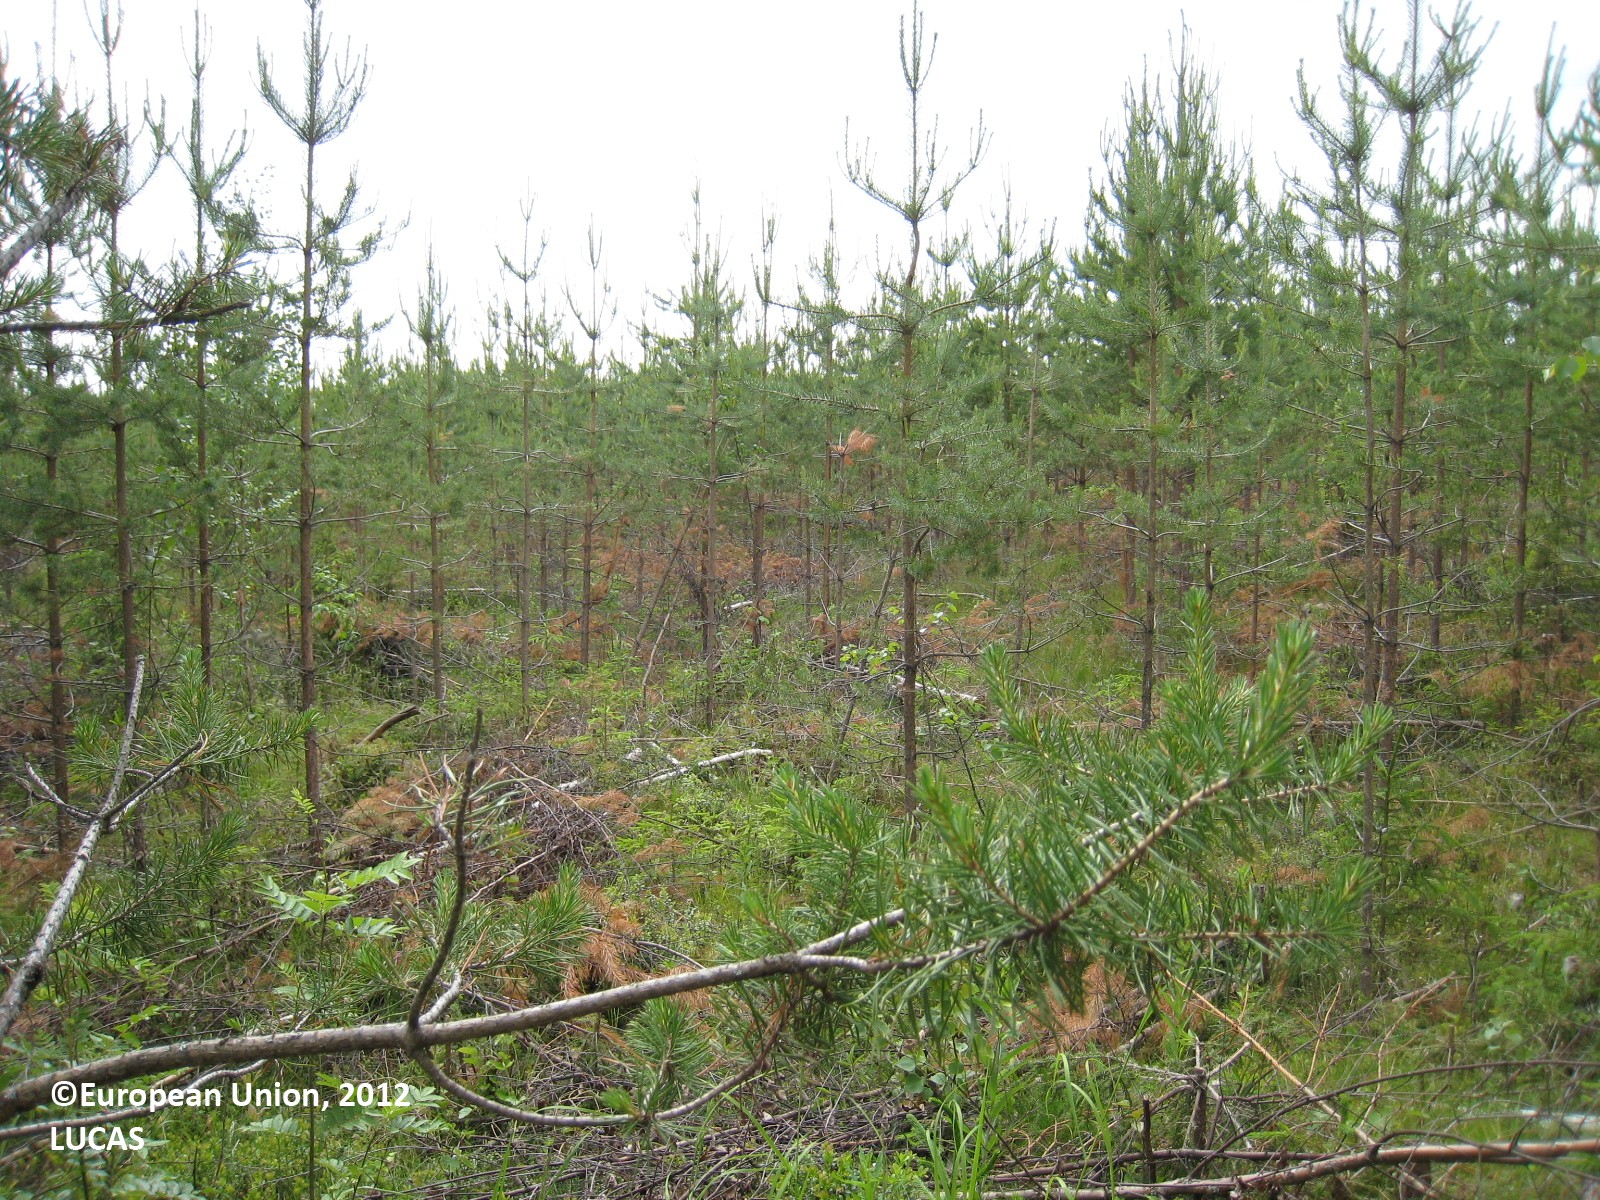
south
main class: Woodland
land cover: Broadleaved woodland
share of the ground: 50 - 75 %
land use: Forestry
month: June
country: FI
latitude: 62.2223
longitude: 26.3901
